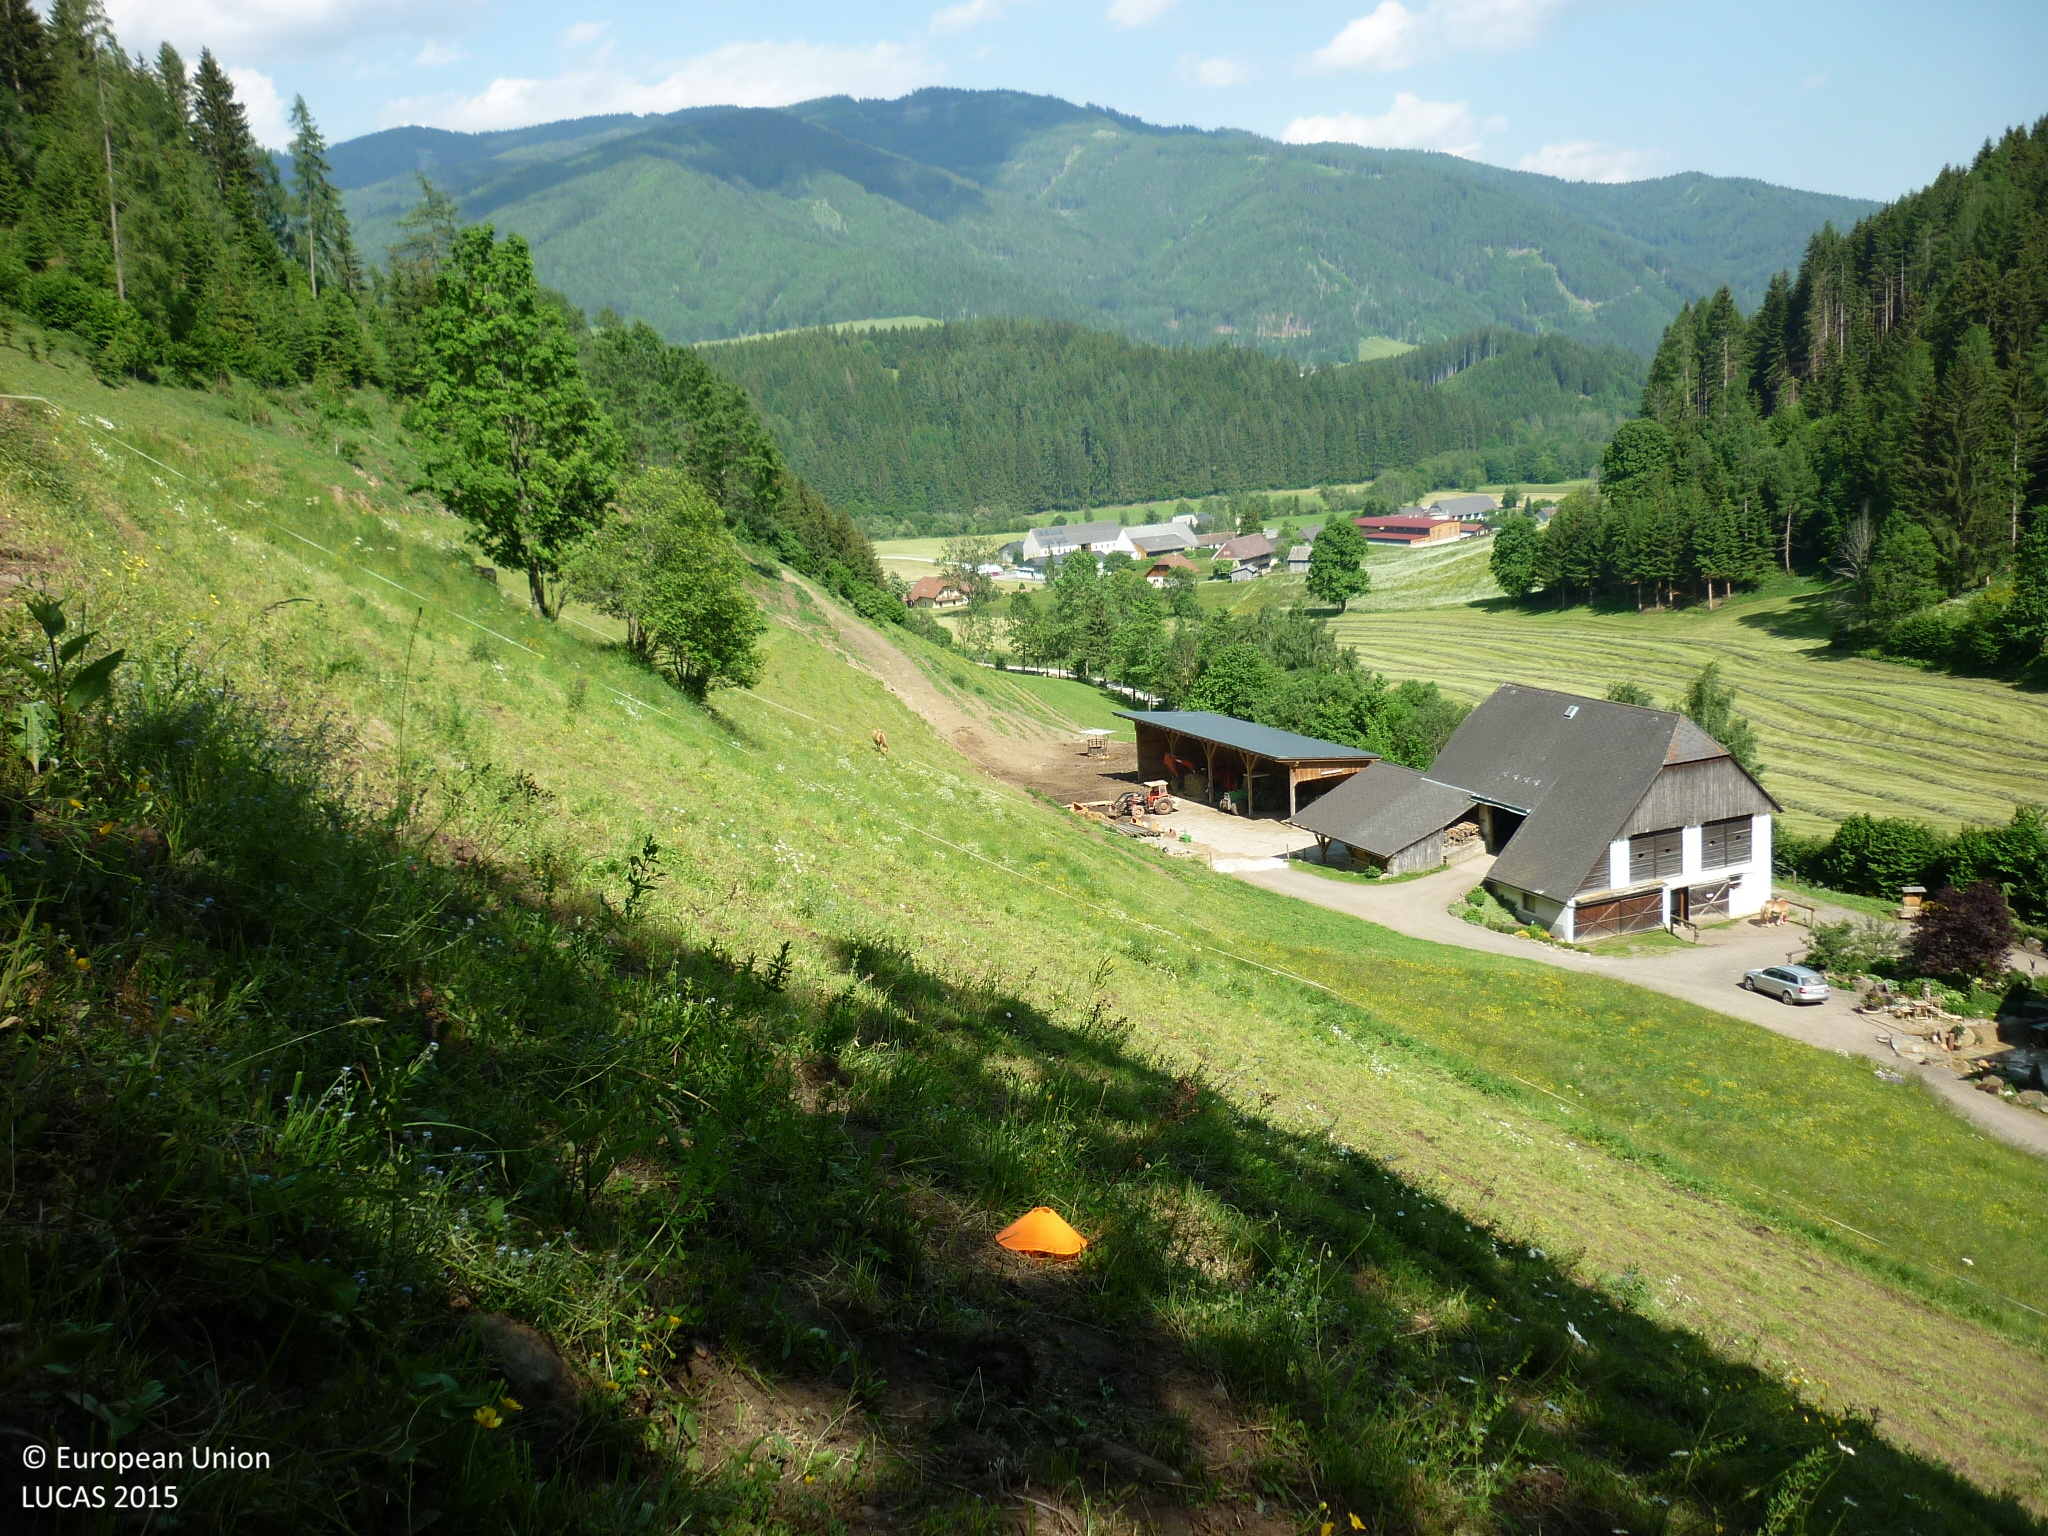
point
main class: Grassland
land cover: Grassland without tree/shrub cover
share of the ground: > 75 %
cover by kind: herbaceous plants 80 %, unconsolidated bare surface 20 %
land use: Agriculture (excluding fallow land and kitchen gardens)
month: June
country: AT
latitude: 47.2673
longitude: 14.4793
